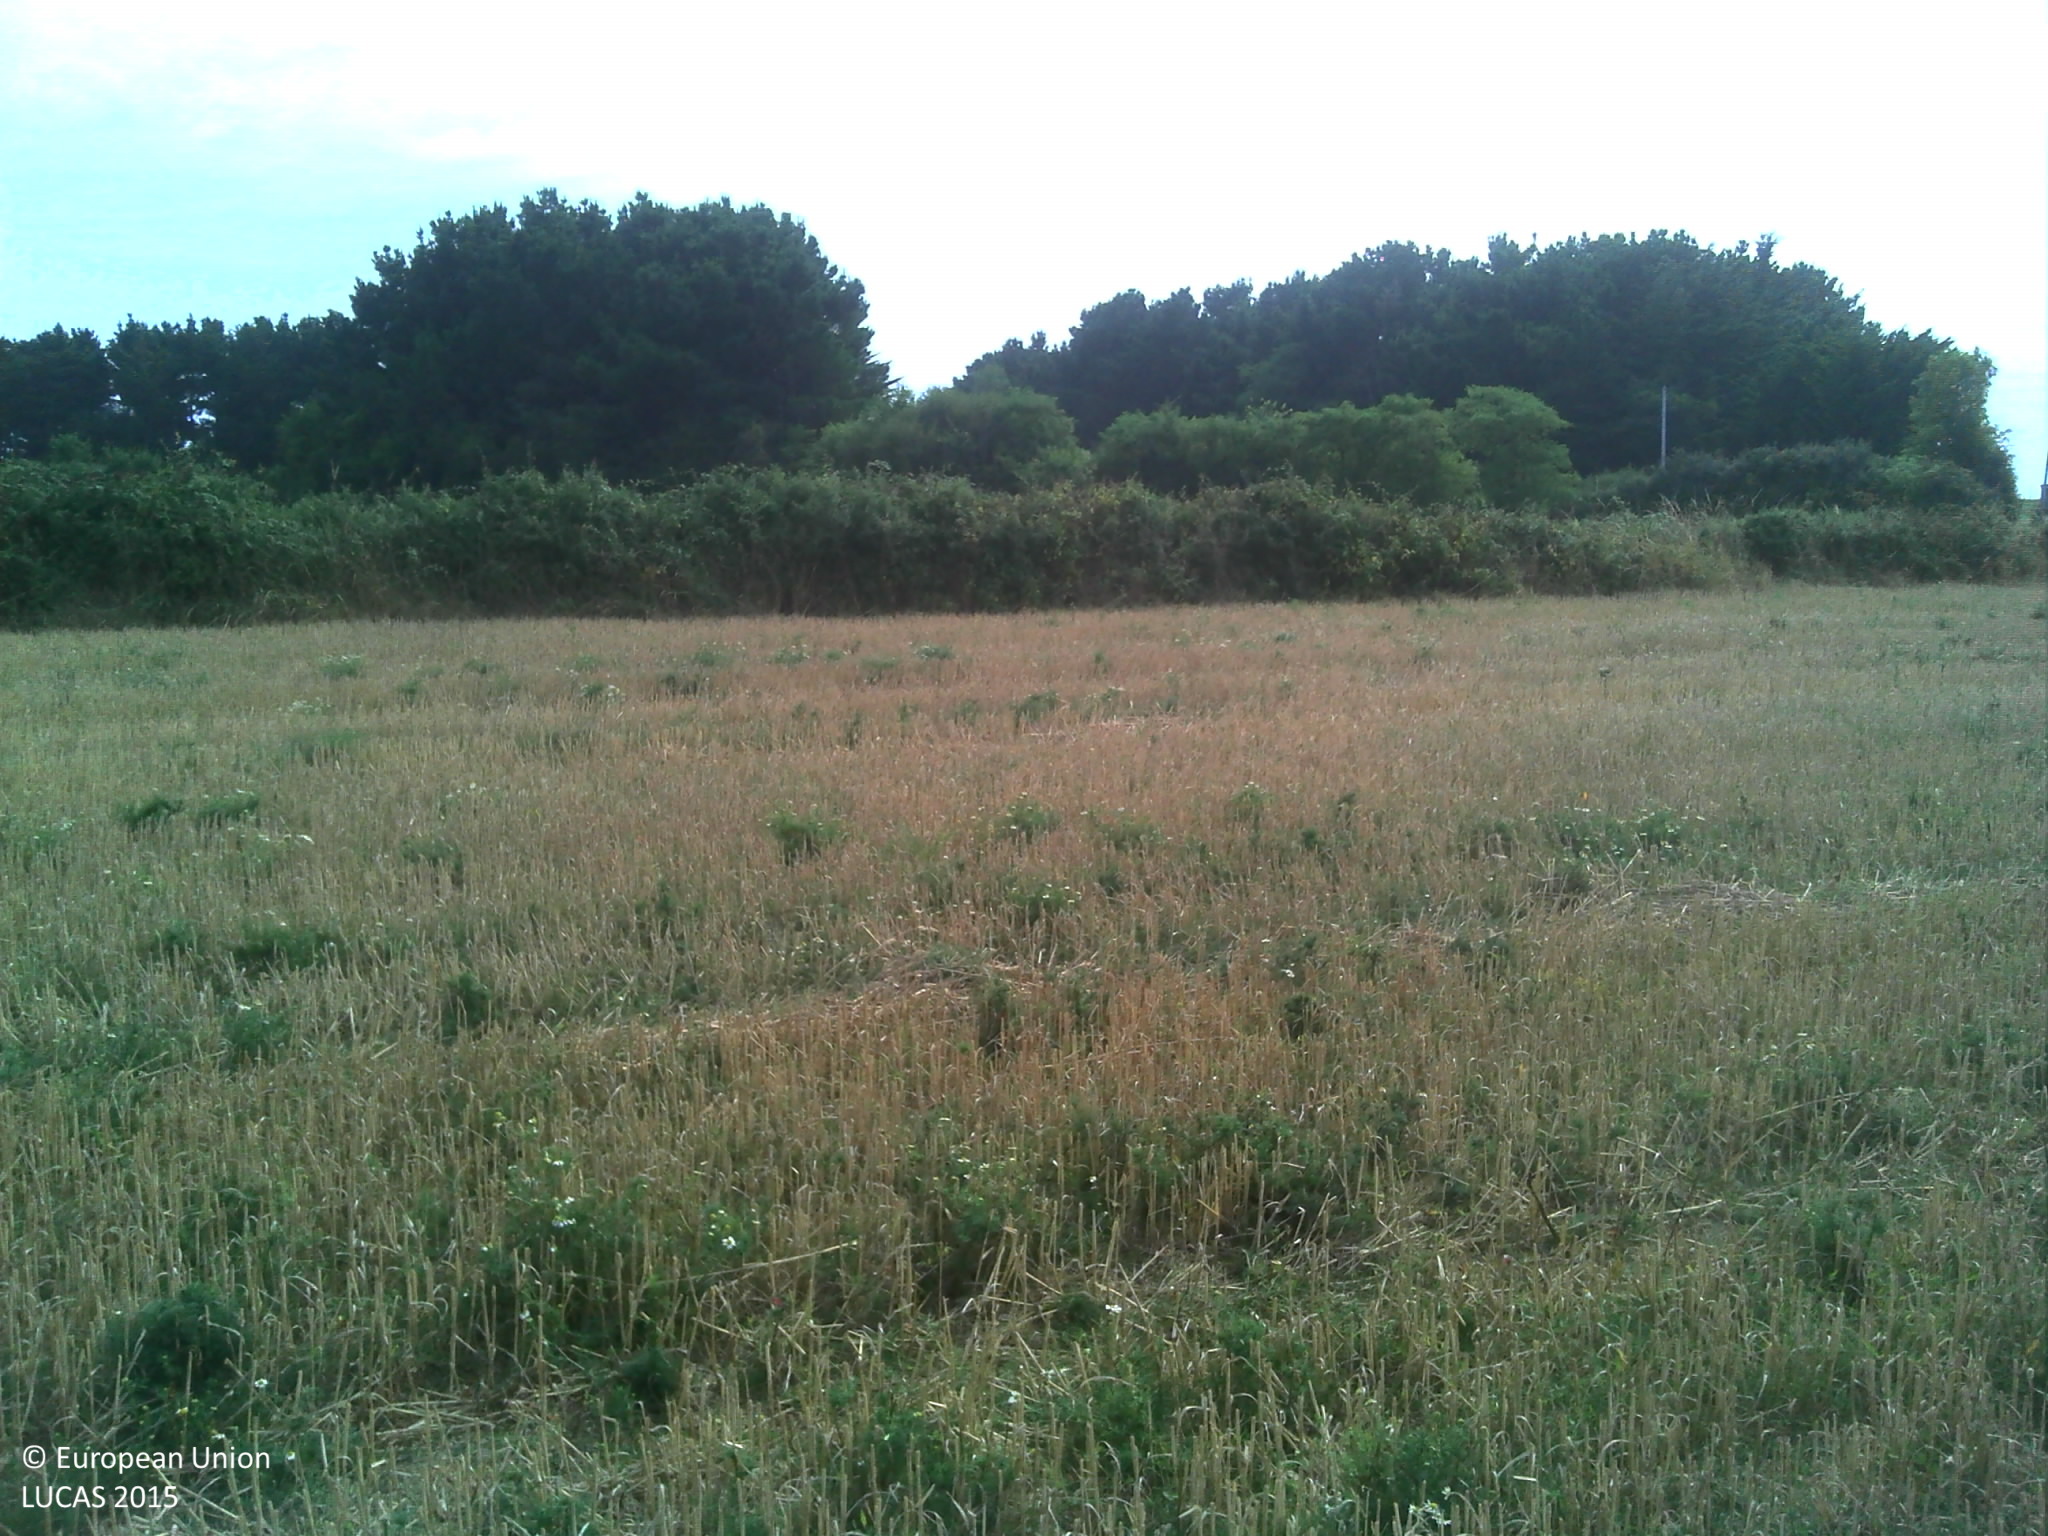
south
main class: Cropland
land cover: Common wheat
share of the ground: > 75 %
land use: Agriculture (excluding fallow land and kitchen gardens)
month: August
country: FR
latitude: 46.6847
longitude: -1.9026
